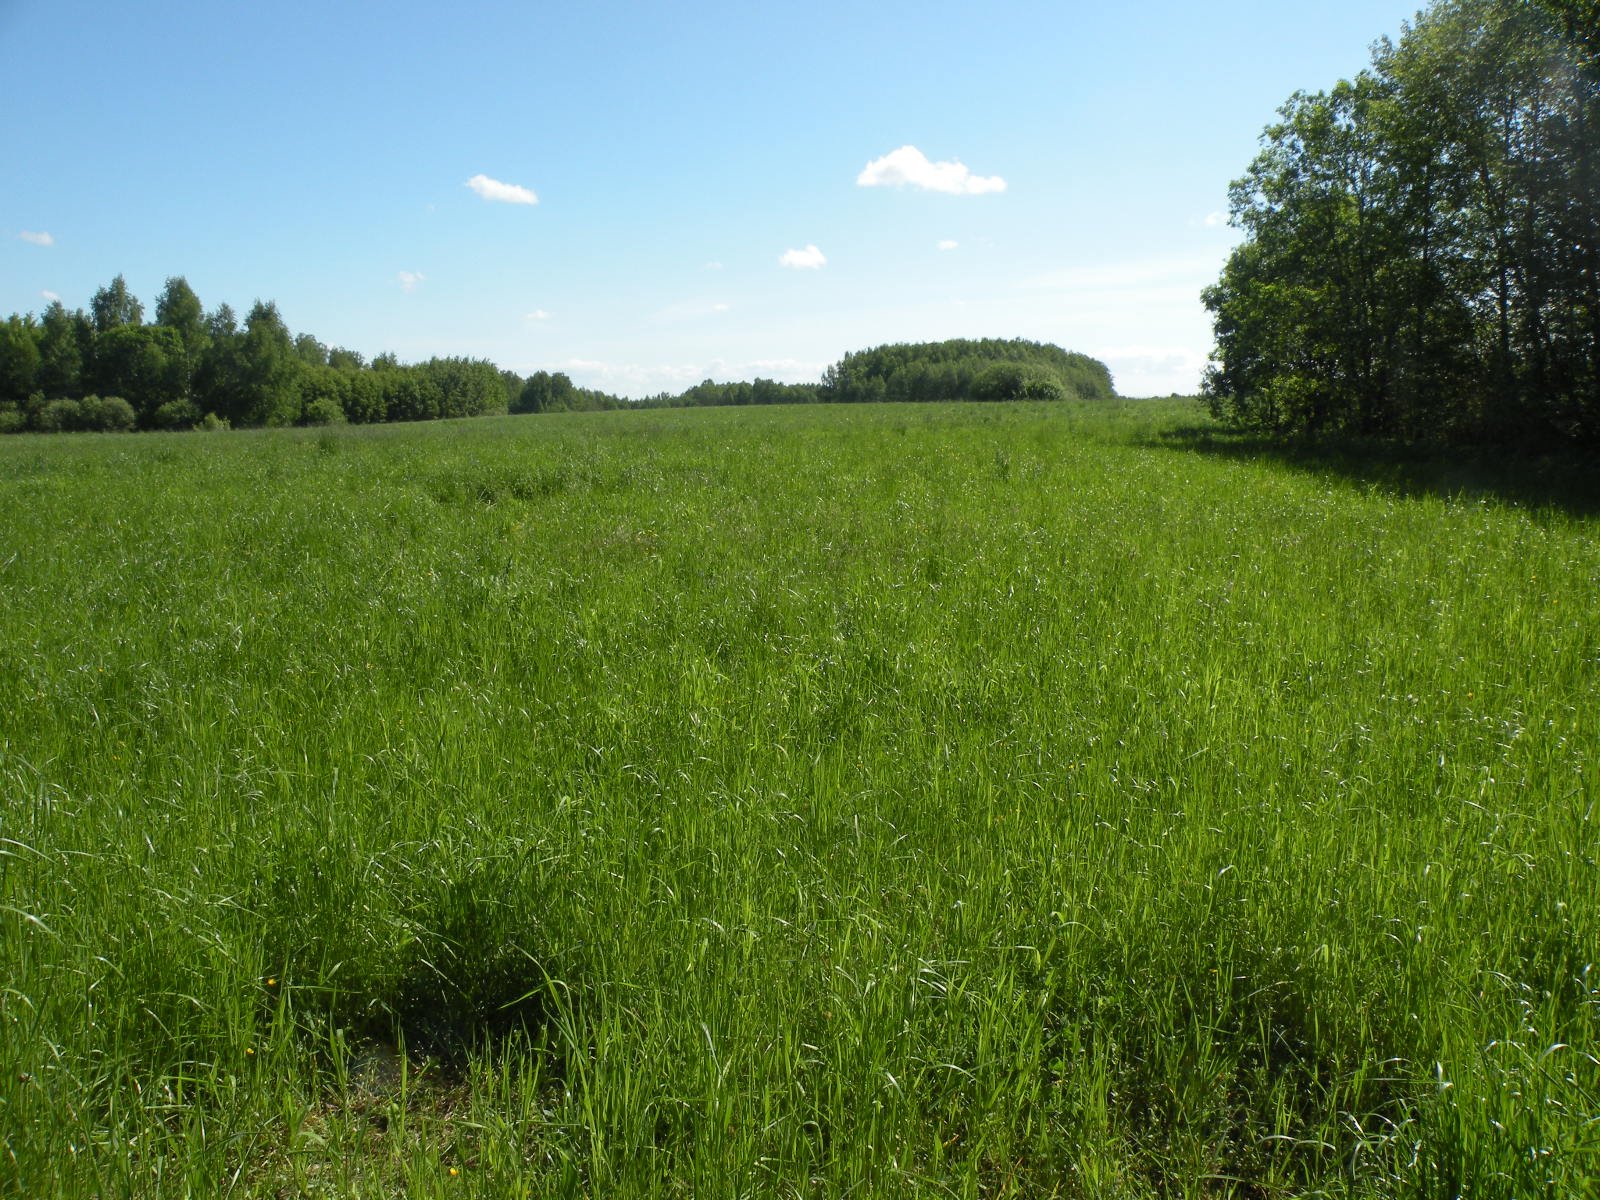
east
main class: Grassland
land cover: Grassland without tree/shrub cover
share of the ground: > 75 %
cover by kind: herbaceous plants 100 %
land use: Agriculture (excluding fallow land and kitchen gardens)
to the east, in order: Grassland without tree/shrub cover; Common wheat
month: May
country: LV
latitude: 56.0259
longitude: 26.2360
